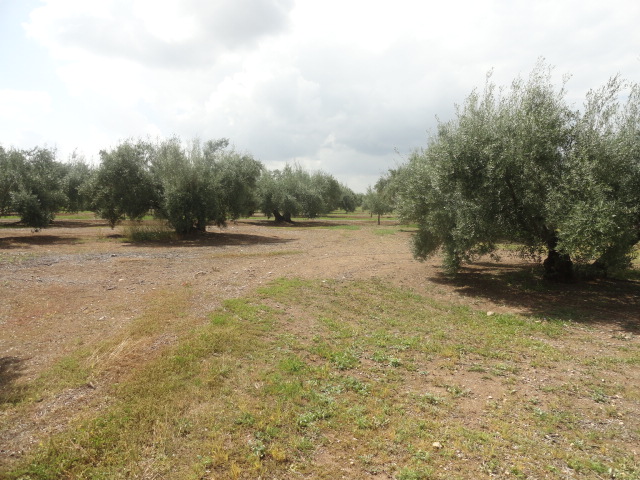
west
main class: Cropland
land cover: Olive groves
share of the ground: 50 - 75 %
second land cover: Spontaneously vegetated surfaces
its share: 25 - 50 %
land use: Agriculture (excluding fallow land and kitchen gardens)
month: April
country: ES
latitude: 37.6162
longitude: -4.5421
